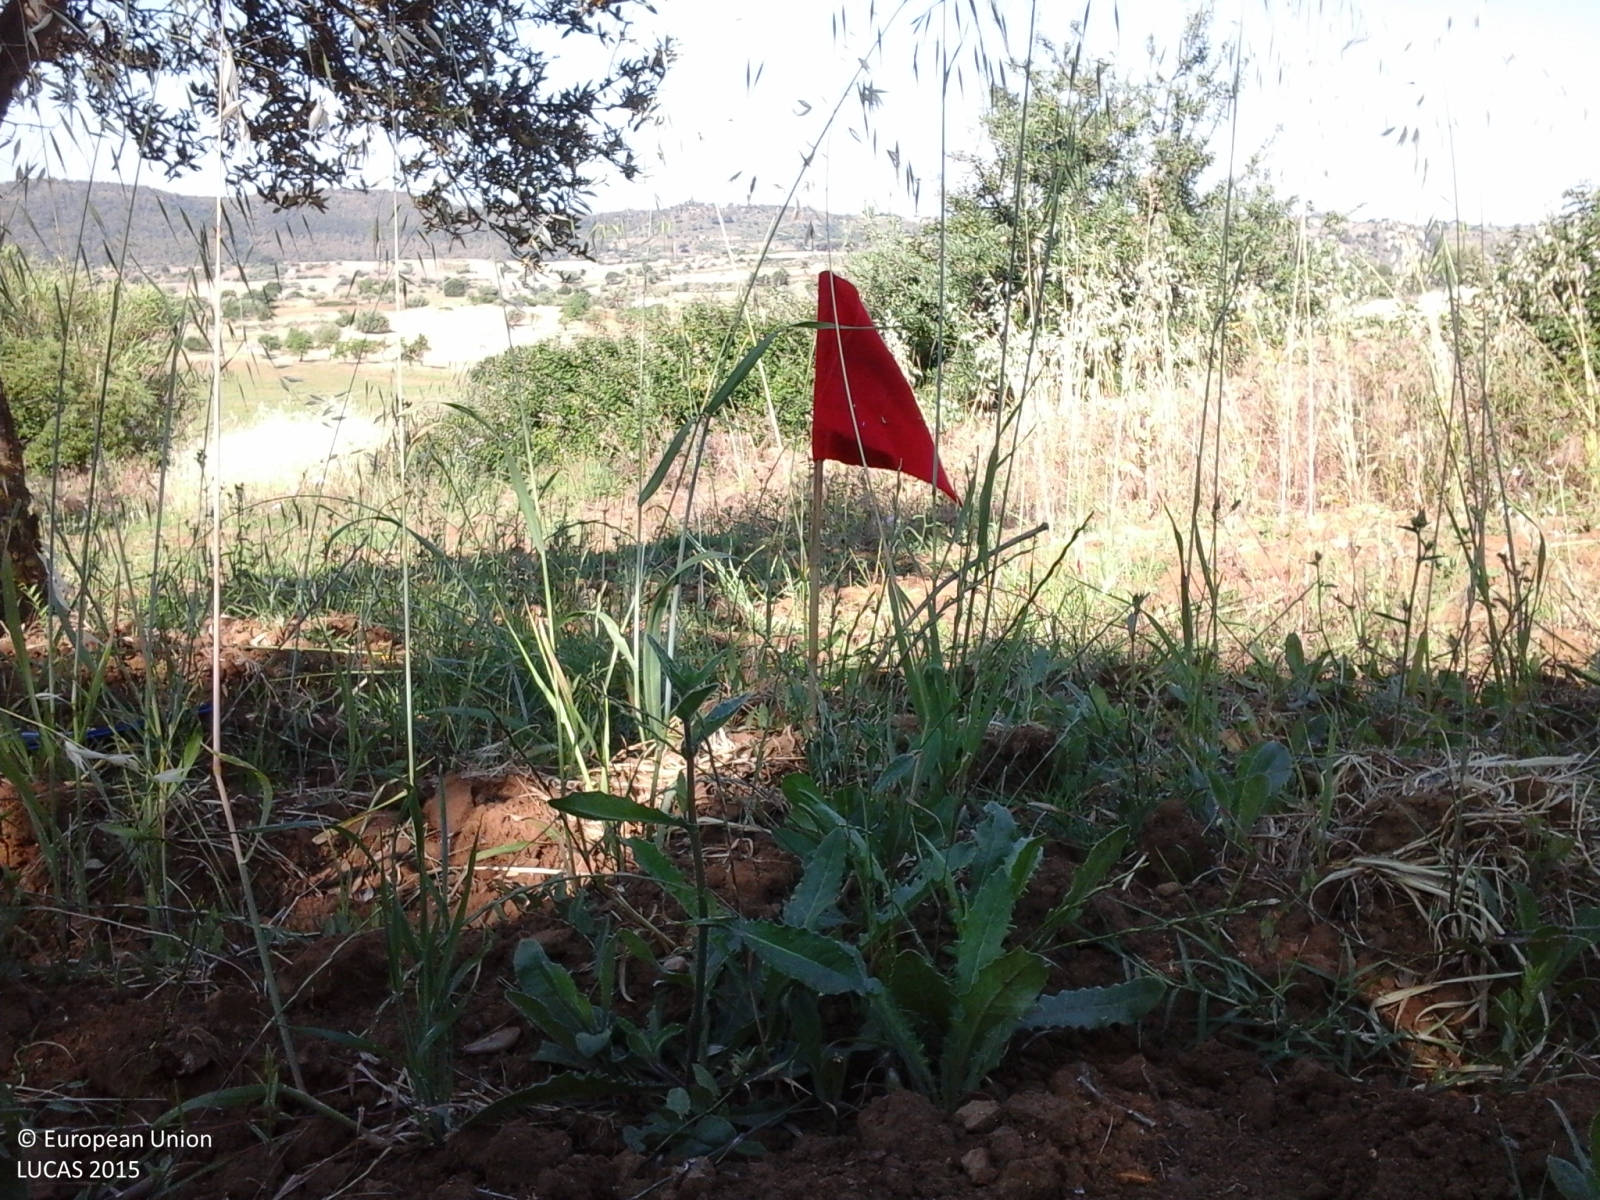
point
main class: Cropland
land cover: Olive groves
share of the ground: 50 - 75 %
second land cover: Spontaneously vegetated surfaces
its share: 10 - 25 %
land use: Agriculture (excluding fallow land and kitchen gardens)
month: June
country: IT
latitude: 37.3365
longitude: 14.4025
